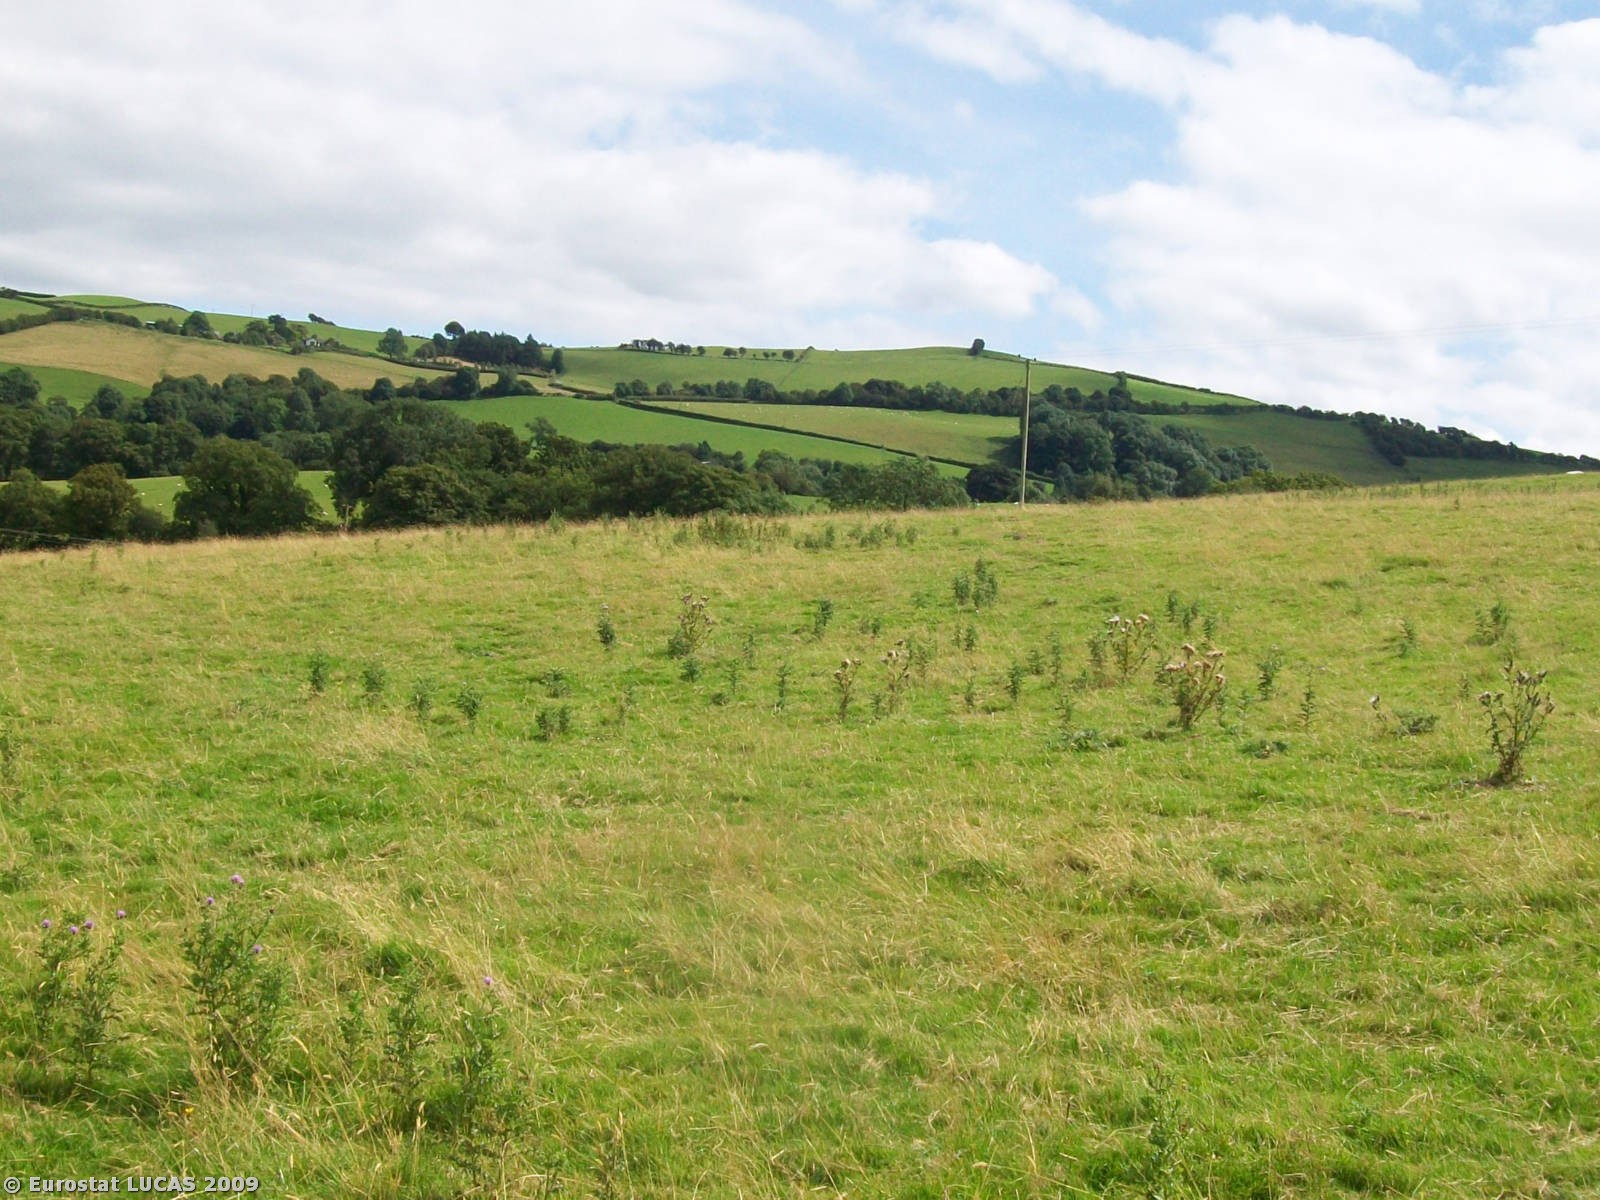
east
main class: Grassland
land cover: Grassland without tree/shrub cover
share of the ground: > 75 %
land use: Agriculture (excluding fallow land and kitchen gardens)
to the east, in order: Grassland without tree/shrub cover; Broadleaved woodland; Inland running water; Abandoned hedges; Grassland without tree/shrub cover; Fences; Lines of trees; Grass margins; Paved roads, cycling and walking lanes; Managed hedges; Grassland without tree/shrub cover; Managed hedges
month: August
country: GB
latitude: 52.4973
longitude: -3.3231
